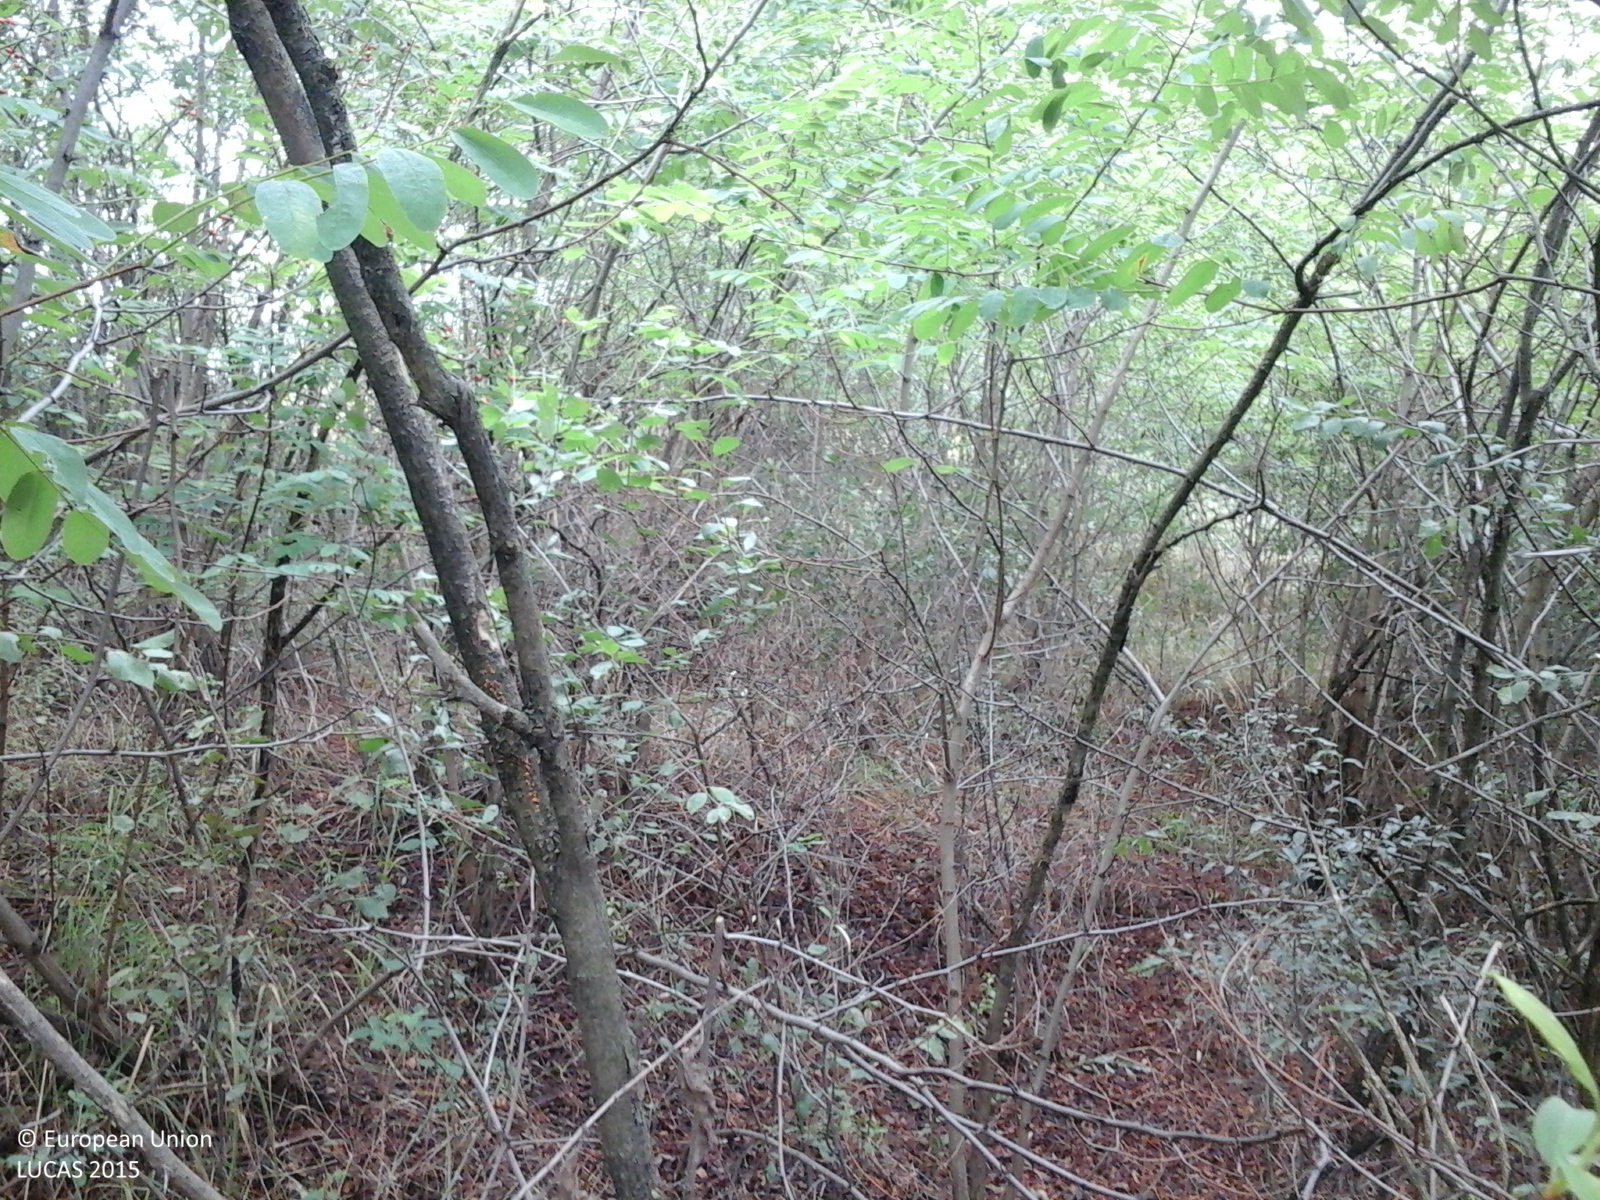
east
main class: Woodland
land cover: Broadleaved woodland
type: exotic forest
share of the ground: > 75 %
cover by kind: broadleaved forest trees 100 %
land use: Forestry
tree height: > 5 m
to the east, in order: Broadleaved woodland; Grassland with sparse tree/shrub cover; Grassland without tree/shrub cover; Grassland with sparse tree/shrub cover; Tracks; Grassland with sparse tree/shrub cover
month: September
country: RO
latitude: 47.1697
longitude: 22.1211
